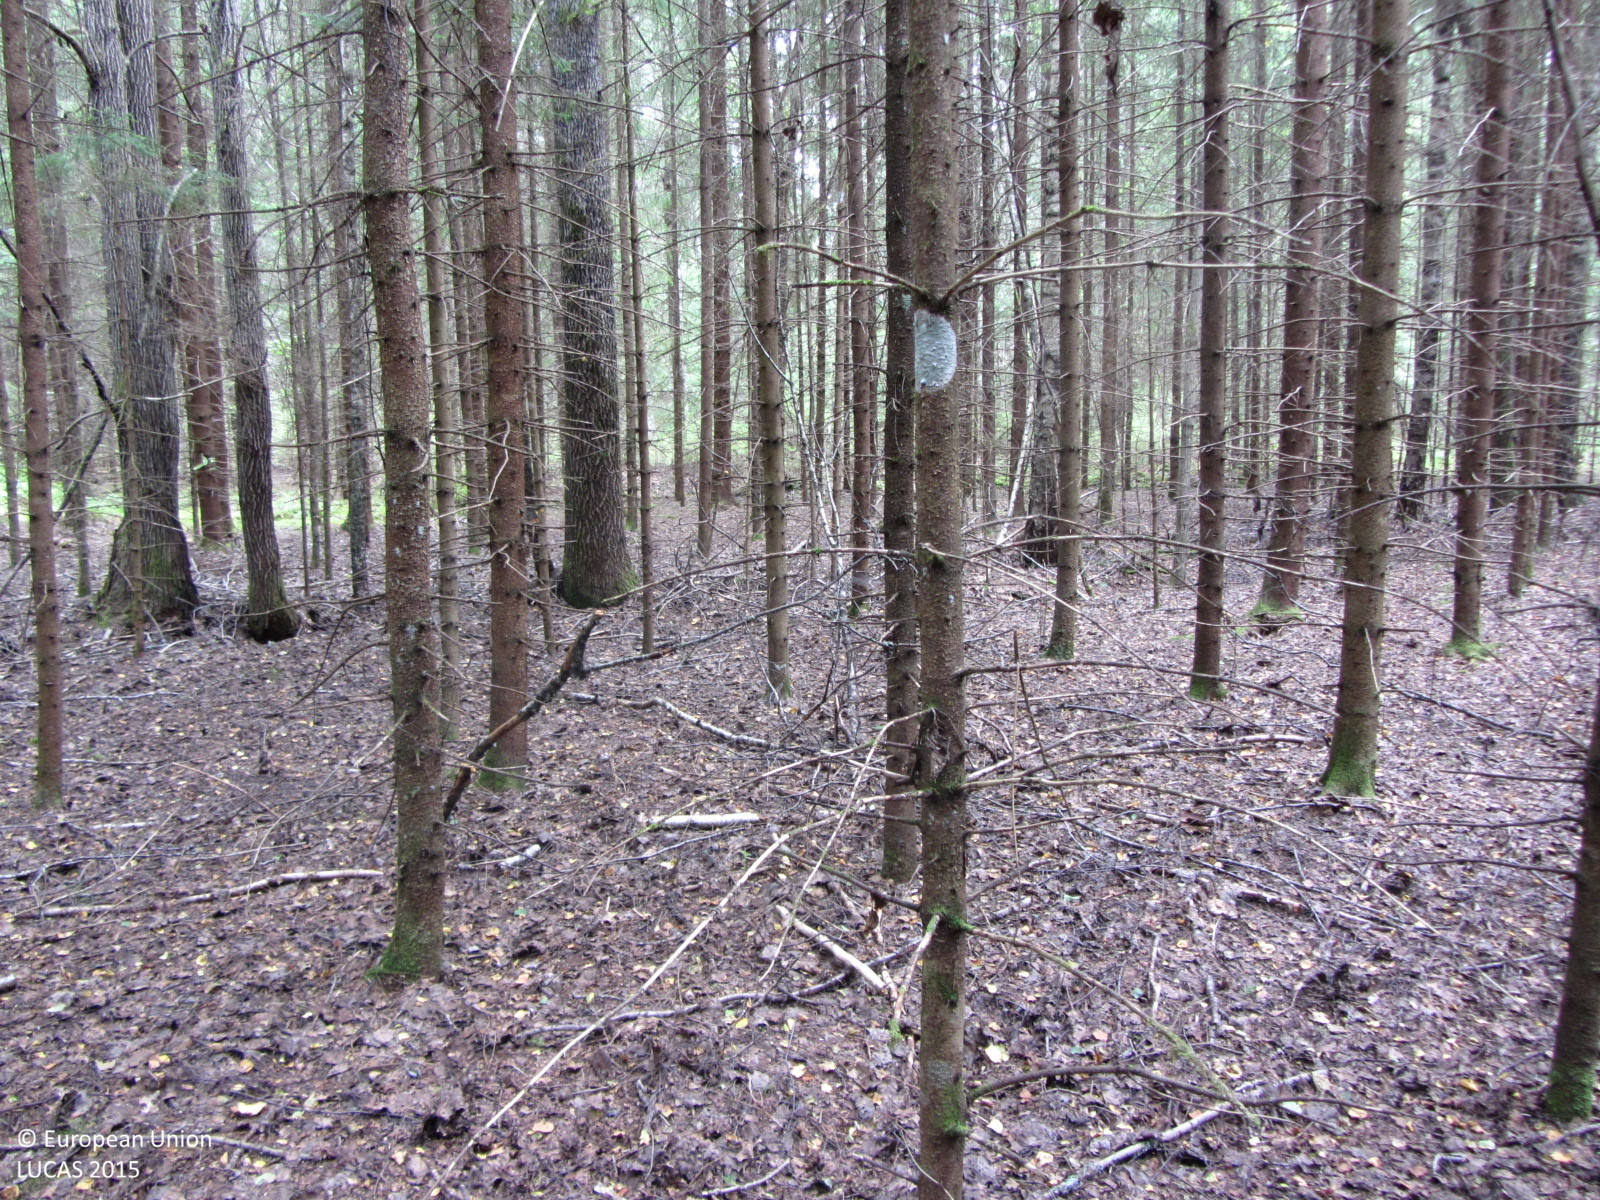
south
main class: Woodland
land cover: Spruce dominated mixed woodland
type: boreal forest
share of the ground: > 75 %
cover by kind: coniferous forest trees 70 %, broadleaved forest trees 30 %
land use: Forestry
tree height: > 5 m
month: August
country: FI
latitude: 60.2835
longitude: 23.8207
